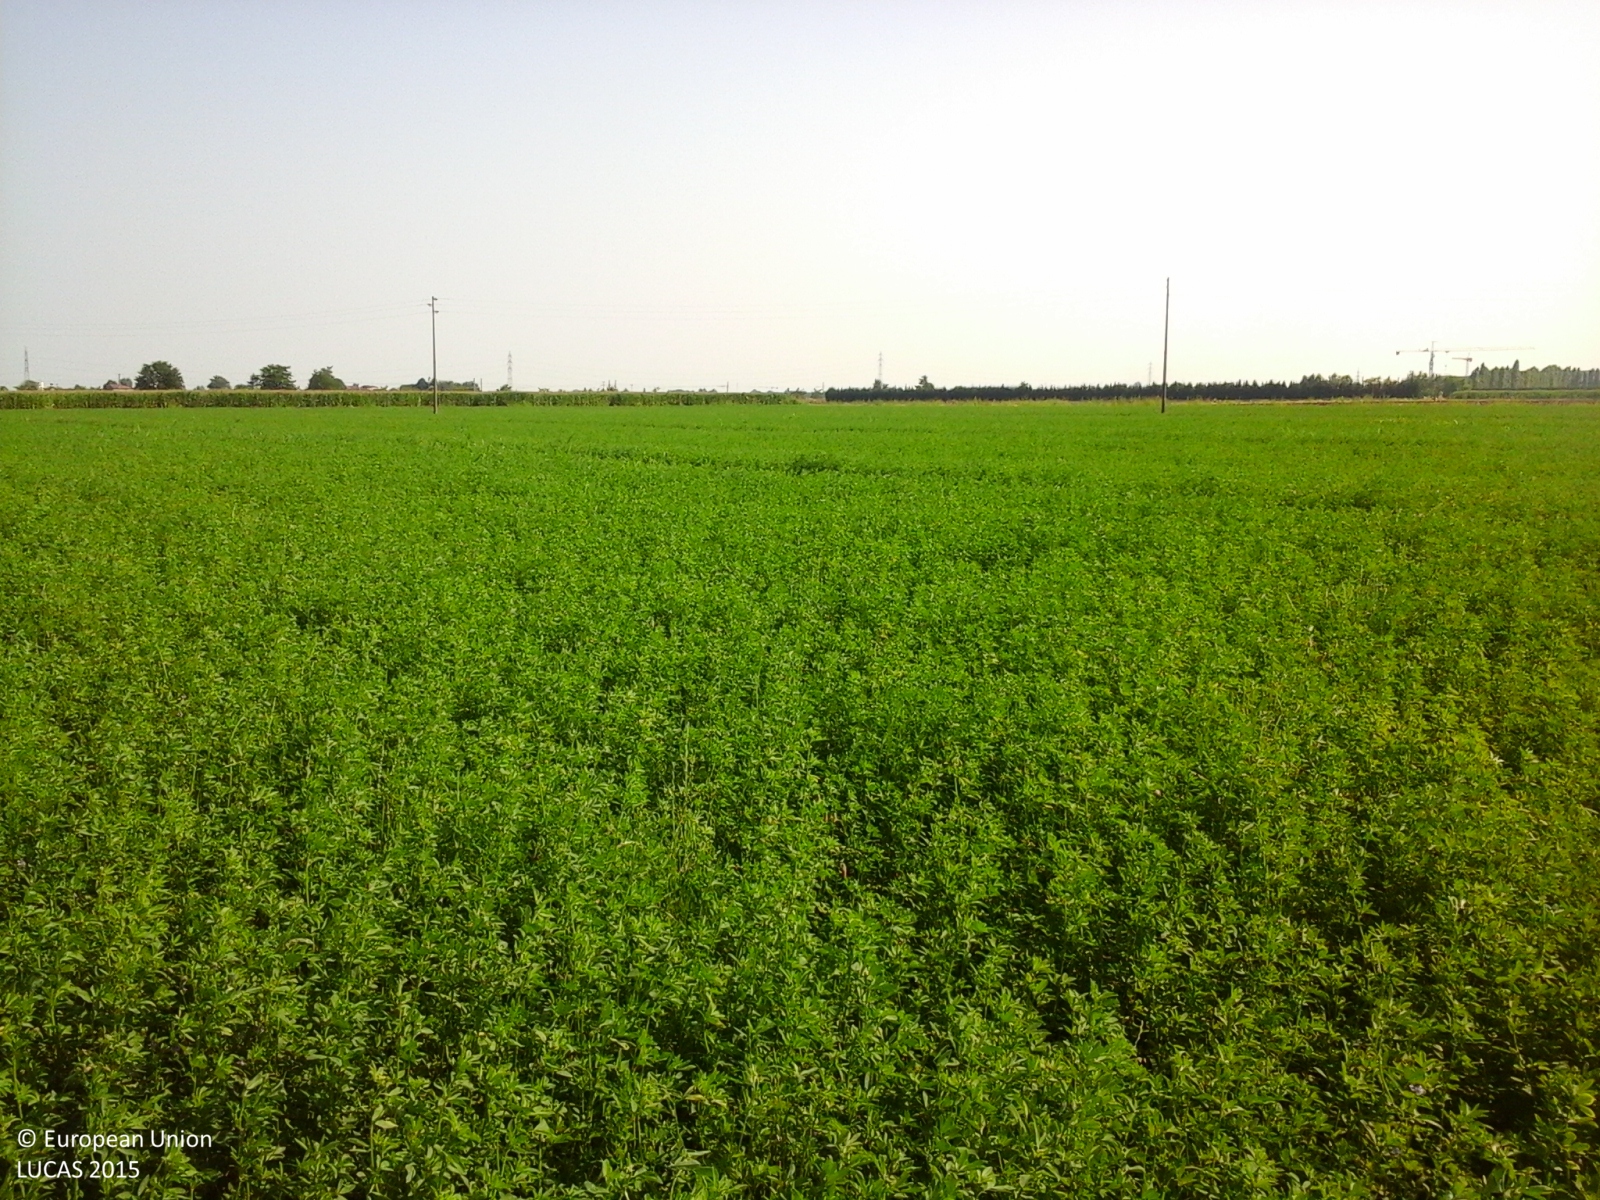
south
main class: Cropland
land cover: Lucerne
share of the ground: > 75 %
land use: Agriculture (excluding fallow land and kitchen gardens)
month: July
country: IT
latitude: 45.3746
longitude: 10.8795
